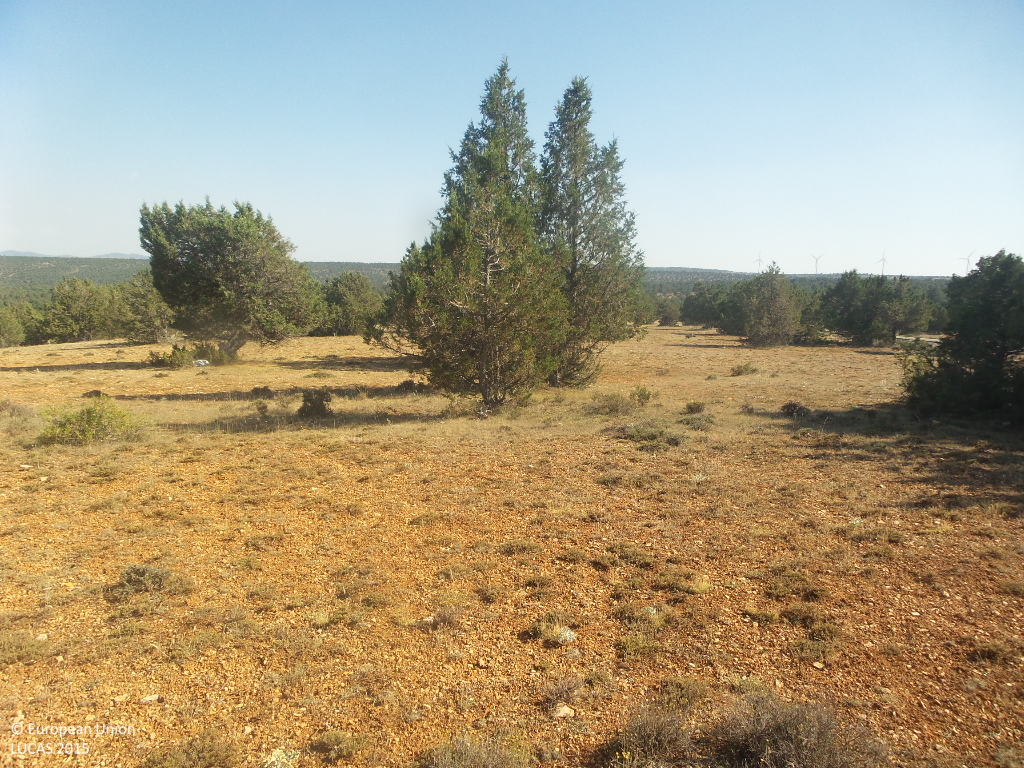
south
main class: Woodland
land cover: Other coniferous woodland
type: coniferous forest of the mediterranean region
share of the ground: 10 - 25 %
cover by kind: unconsolidated bare surface 55 %, coniferous forest trees 20 %, shrubs 20 %, herbaceous plants 5 %
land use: Semi-natural and natural areas not in use
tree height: > 5 m
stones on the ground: < 10 %
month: July
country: ES
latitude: 41.0823
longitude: -2.1328
